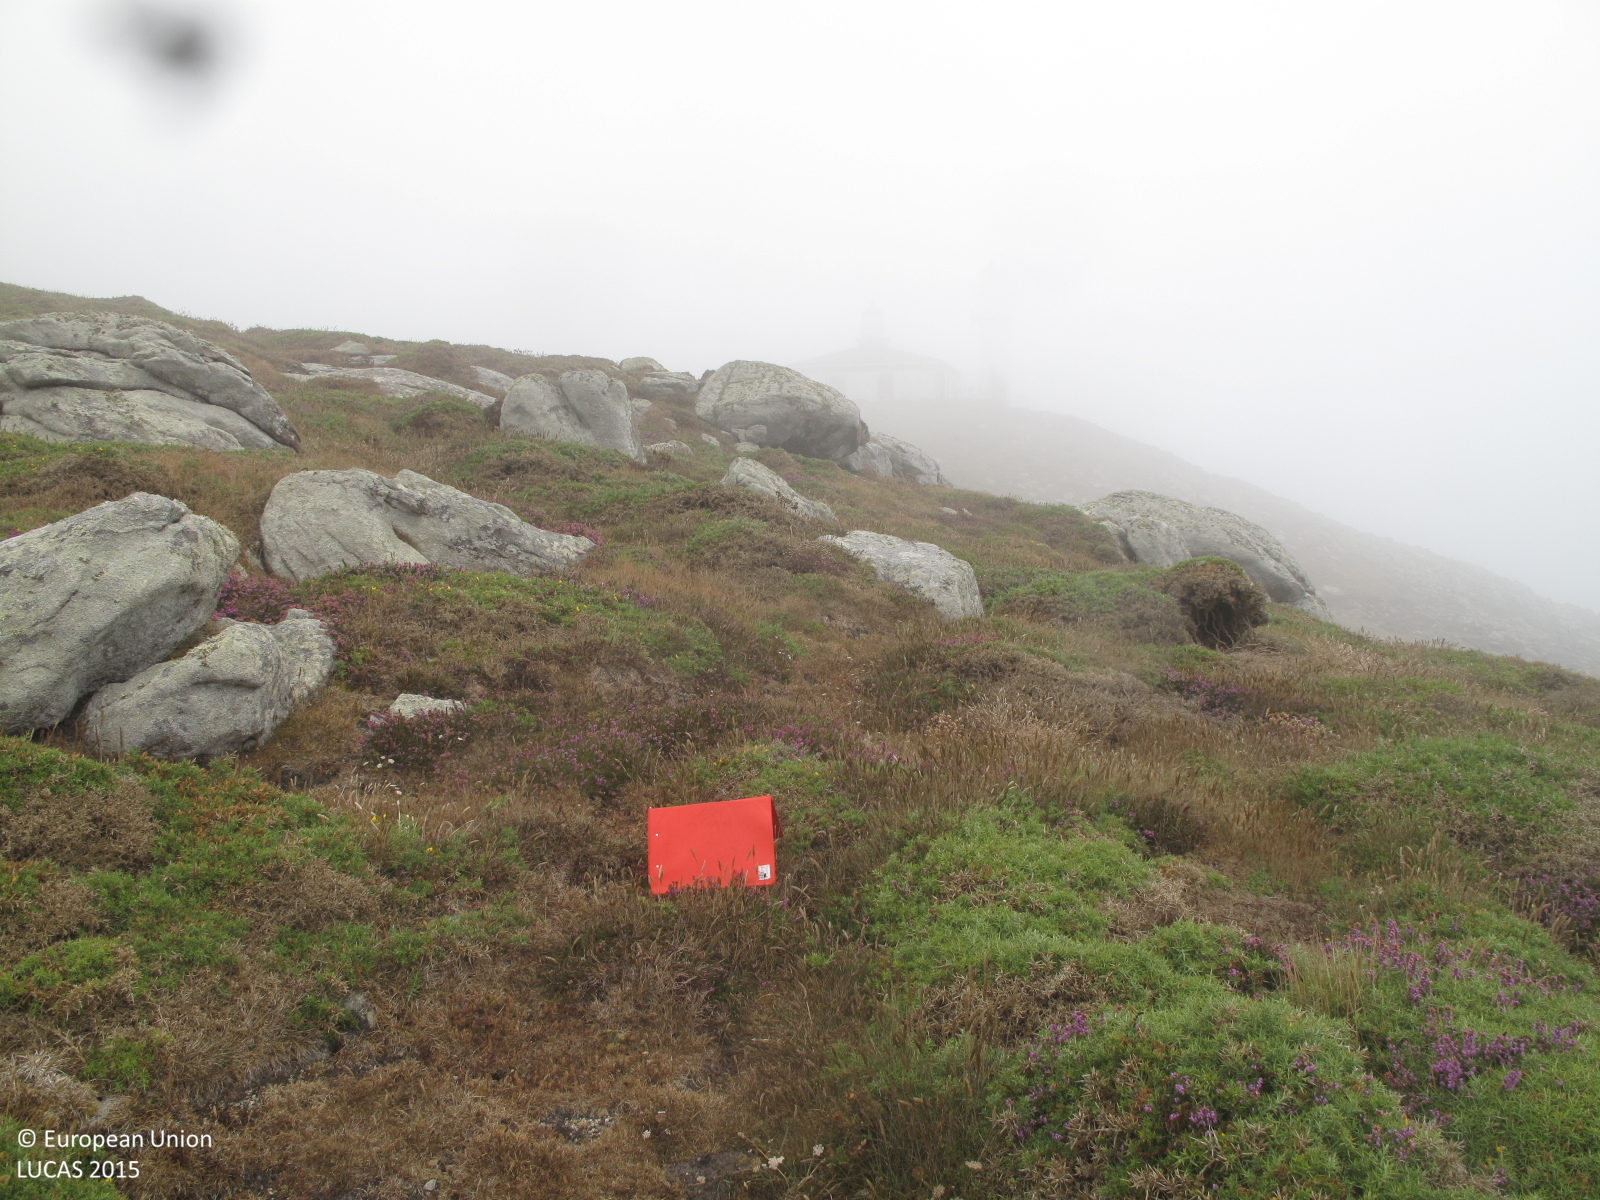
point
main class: Shrubland
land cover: Shrubland without tree cover
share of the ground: 50 - 75 %
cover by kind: shrubs 70 %, herbaceous plants 10 %, lichens and mosses 10 %, consolidated bare surface 10 %
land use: Semi-natural and natural areas not in use
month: July
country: ES
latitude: 43.0544
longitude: -9.2973
